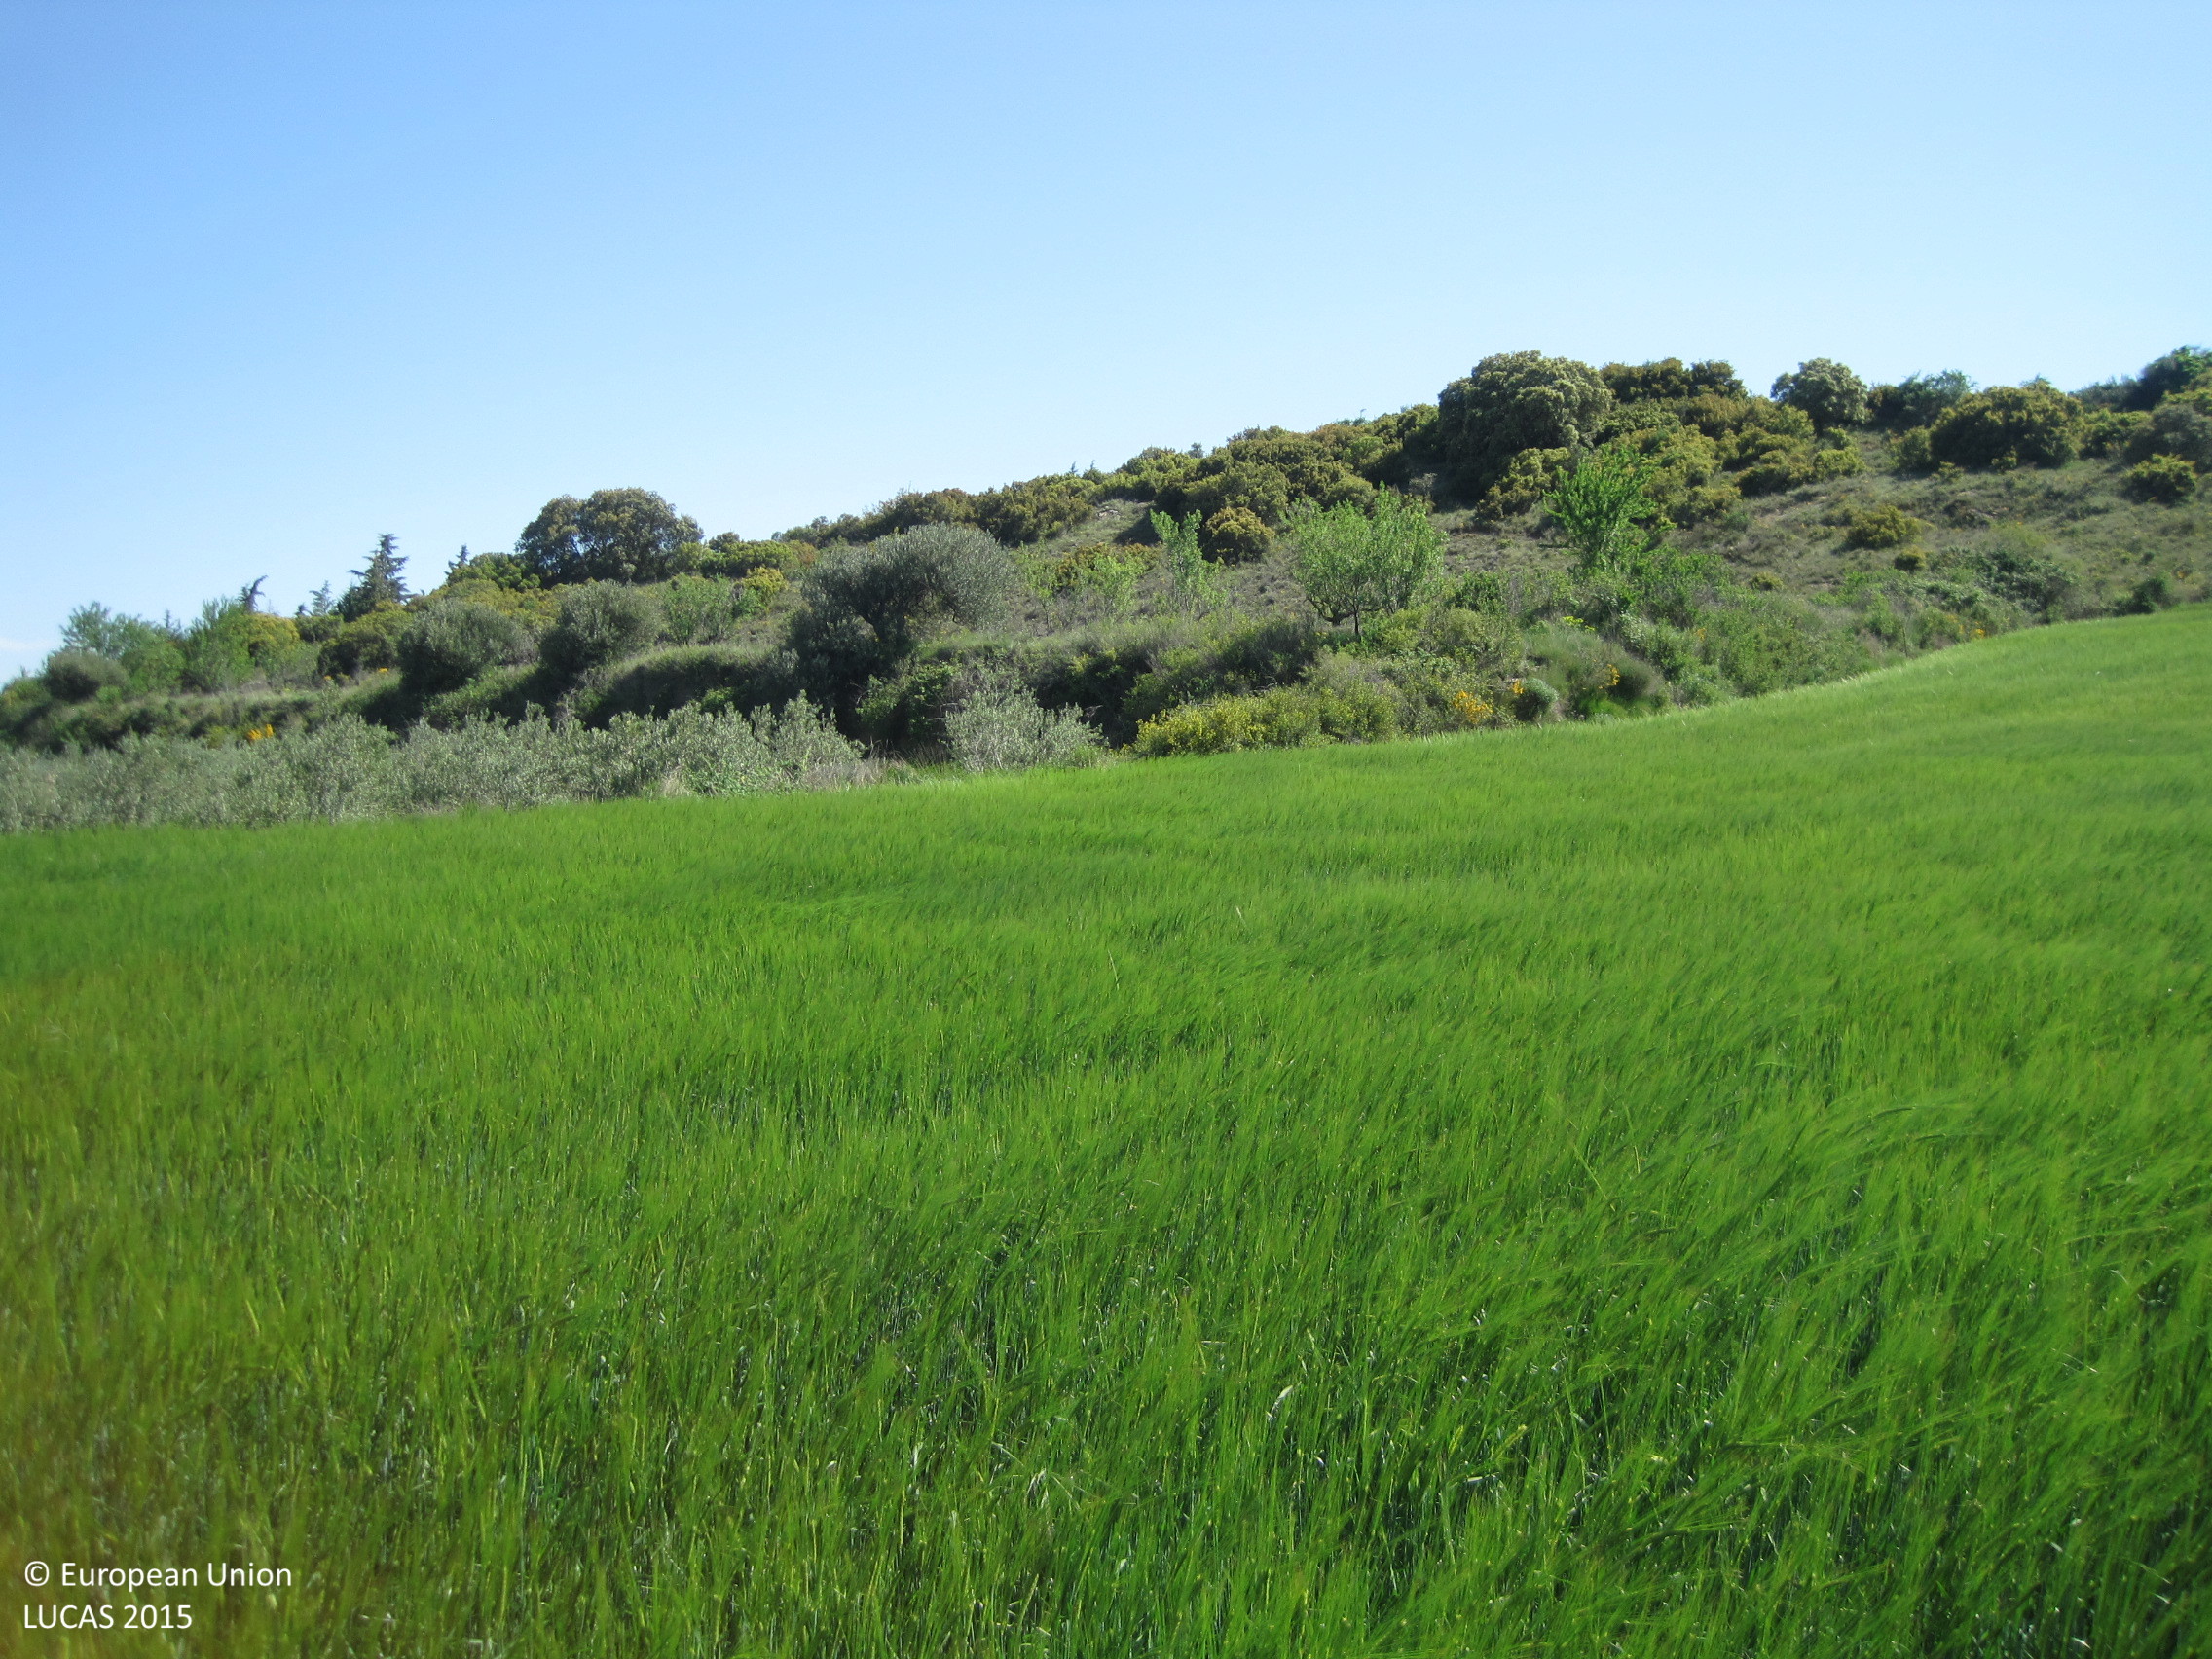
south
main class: Cropland
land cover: Barley
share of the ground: > 75 %
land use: Agriculture (excluding fallow land and kitchen gardens)
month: May
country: ES
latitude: 42.5397
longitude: -1.6898
